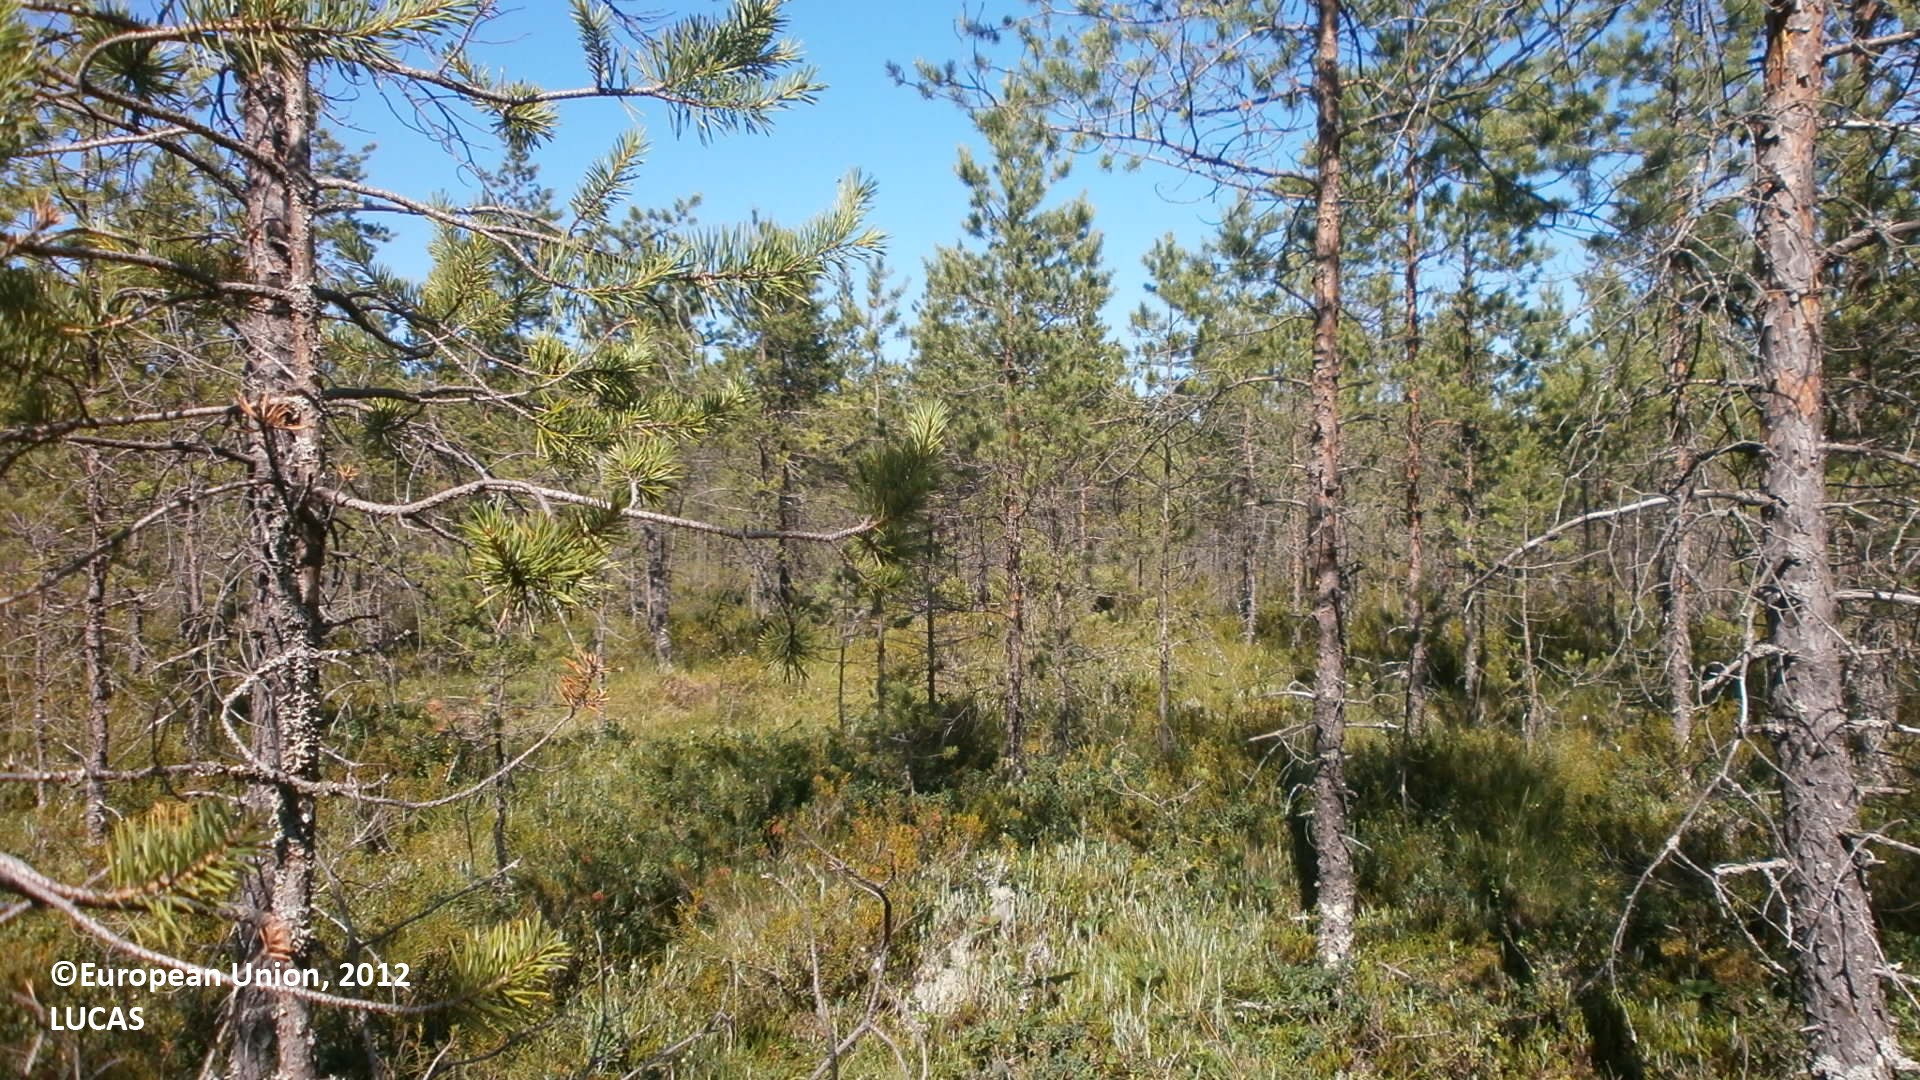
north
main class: Woodland
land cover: Pine dominated coniferous woodland
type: mire and swamp forests
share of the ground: 25 - 50 %
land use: Forestry
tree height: > 5 m
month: July
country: FI
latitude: 64.1720
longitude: 23.8653
